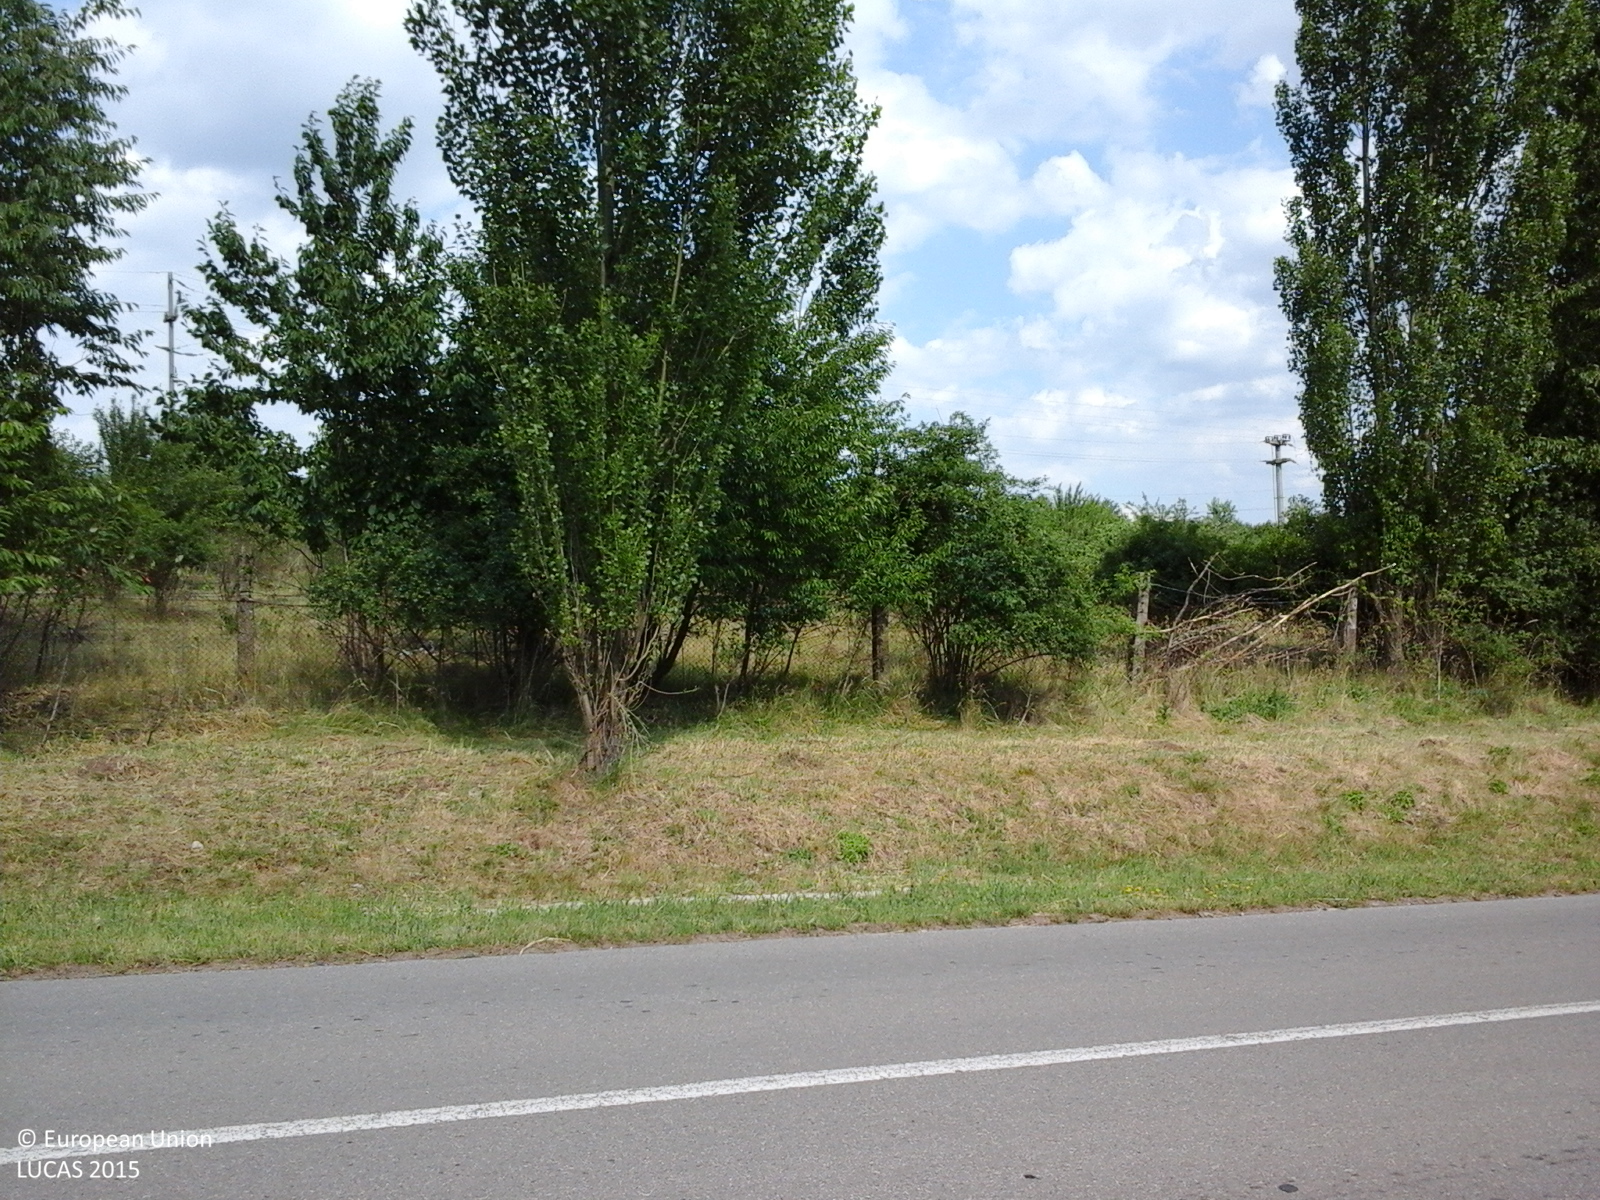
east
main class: Cropland
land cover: Cherry fruit
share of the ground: < 10 %
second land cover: Grassland without tree/shrub cover
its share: > 75 %
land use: Agriculture (excluding fallow land and kitchen gardens)
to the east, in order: Cherry fruit; Grassland without tree/shrub cover; Tracks; Grass margins; Fences; Grass margins; Ditches and canals; Grass margins; Paved roads, cycling and walking lanes; Grass margins; Ditches and canals; Grassland with sparse tree/shrub cover; Fences; Lines of trees; Spontaneously vegetated surfaces; Electric lines; Shrubland with sparse tree cover; Grassland with sparse tree/shrub cover; Fences; Grass margins; Apple fruit
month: June
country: RO
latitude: 47.4750
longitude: 26.3115
